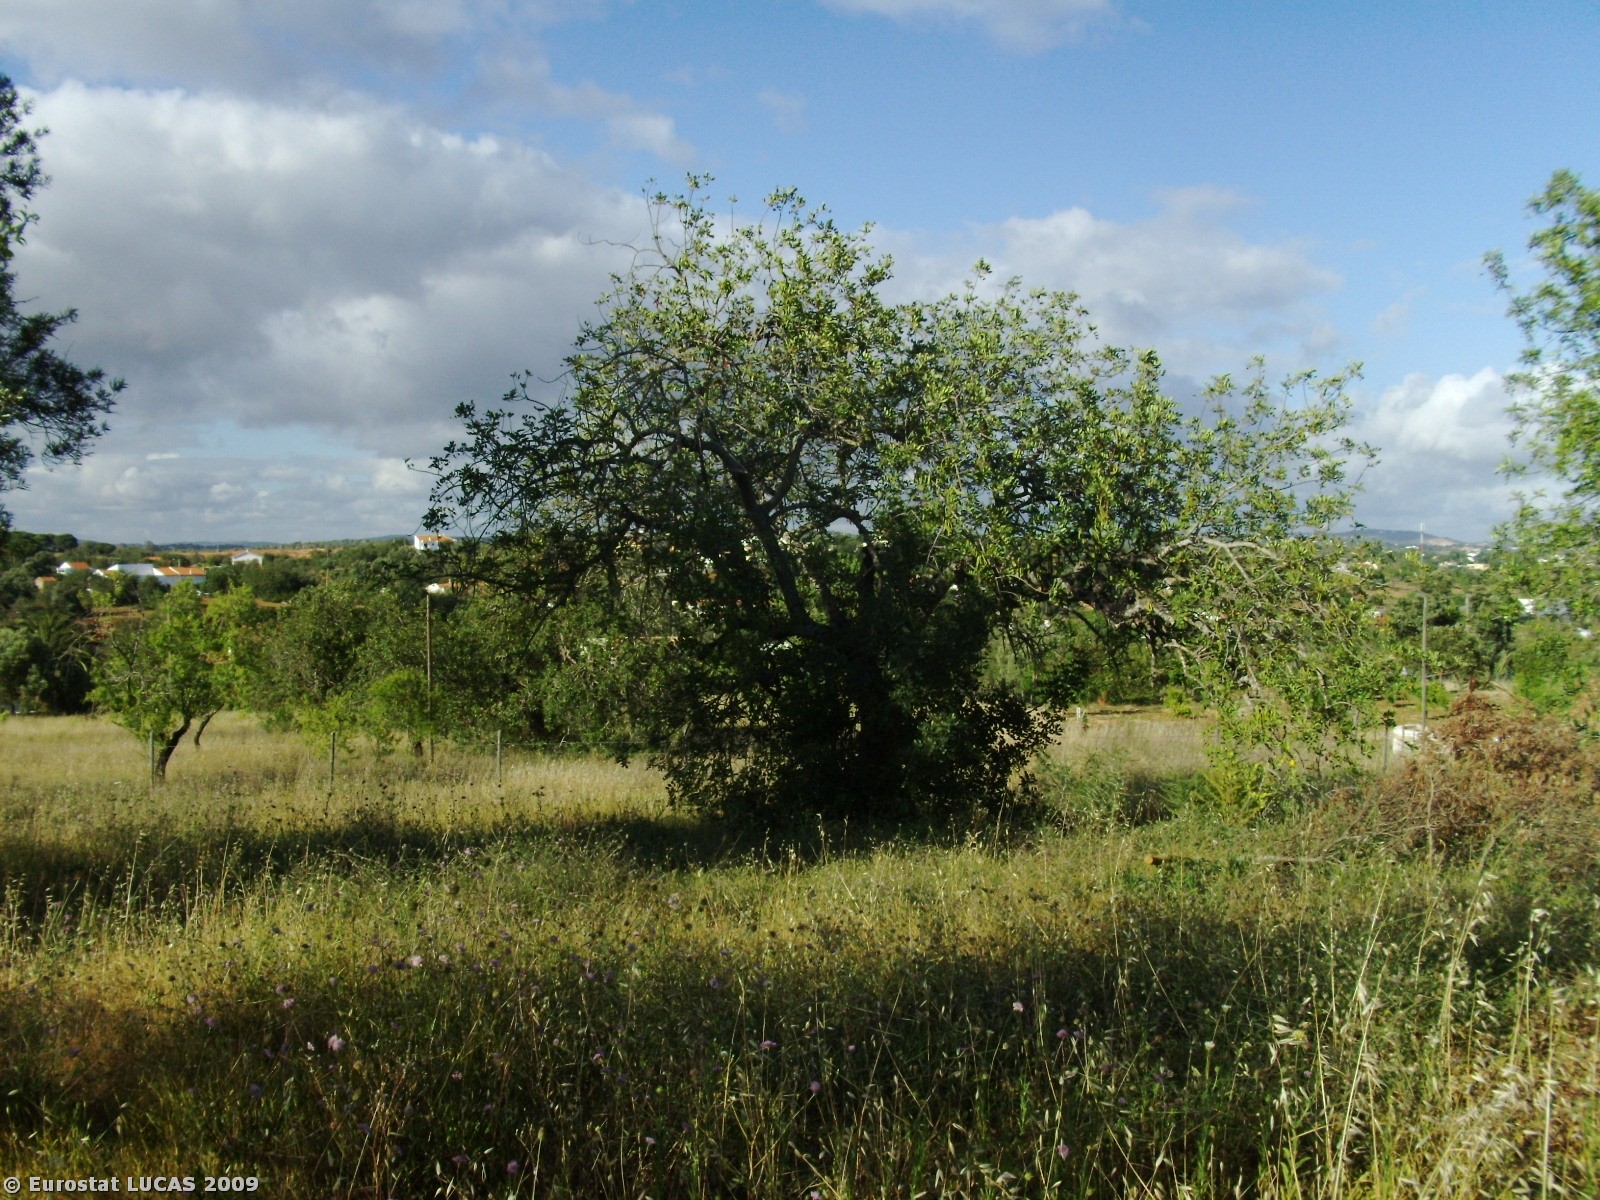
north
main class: Cropland
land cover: Nuts trees
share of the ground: 10 - 25 %
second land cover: Spontaneously vegetated surfaces
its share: 50 - 75 %
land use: Agriculture (excluding fallow land and kitchen gardens)
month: May
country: PT
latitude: 37.1206
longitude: -8.2164
